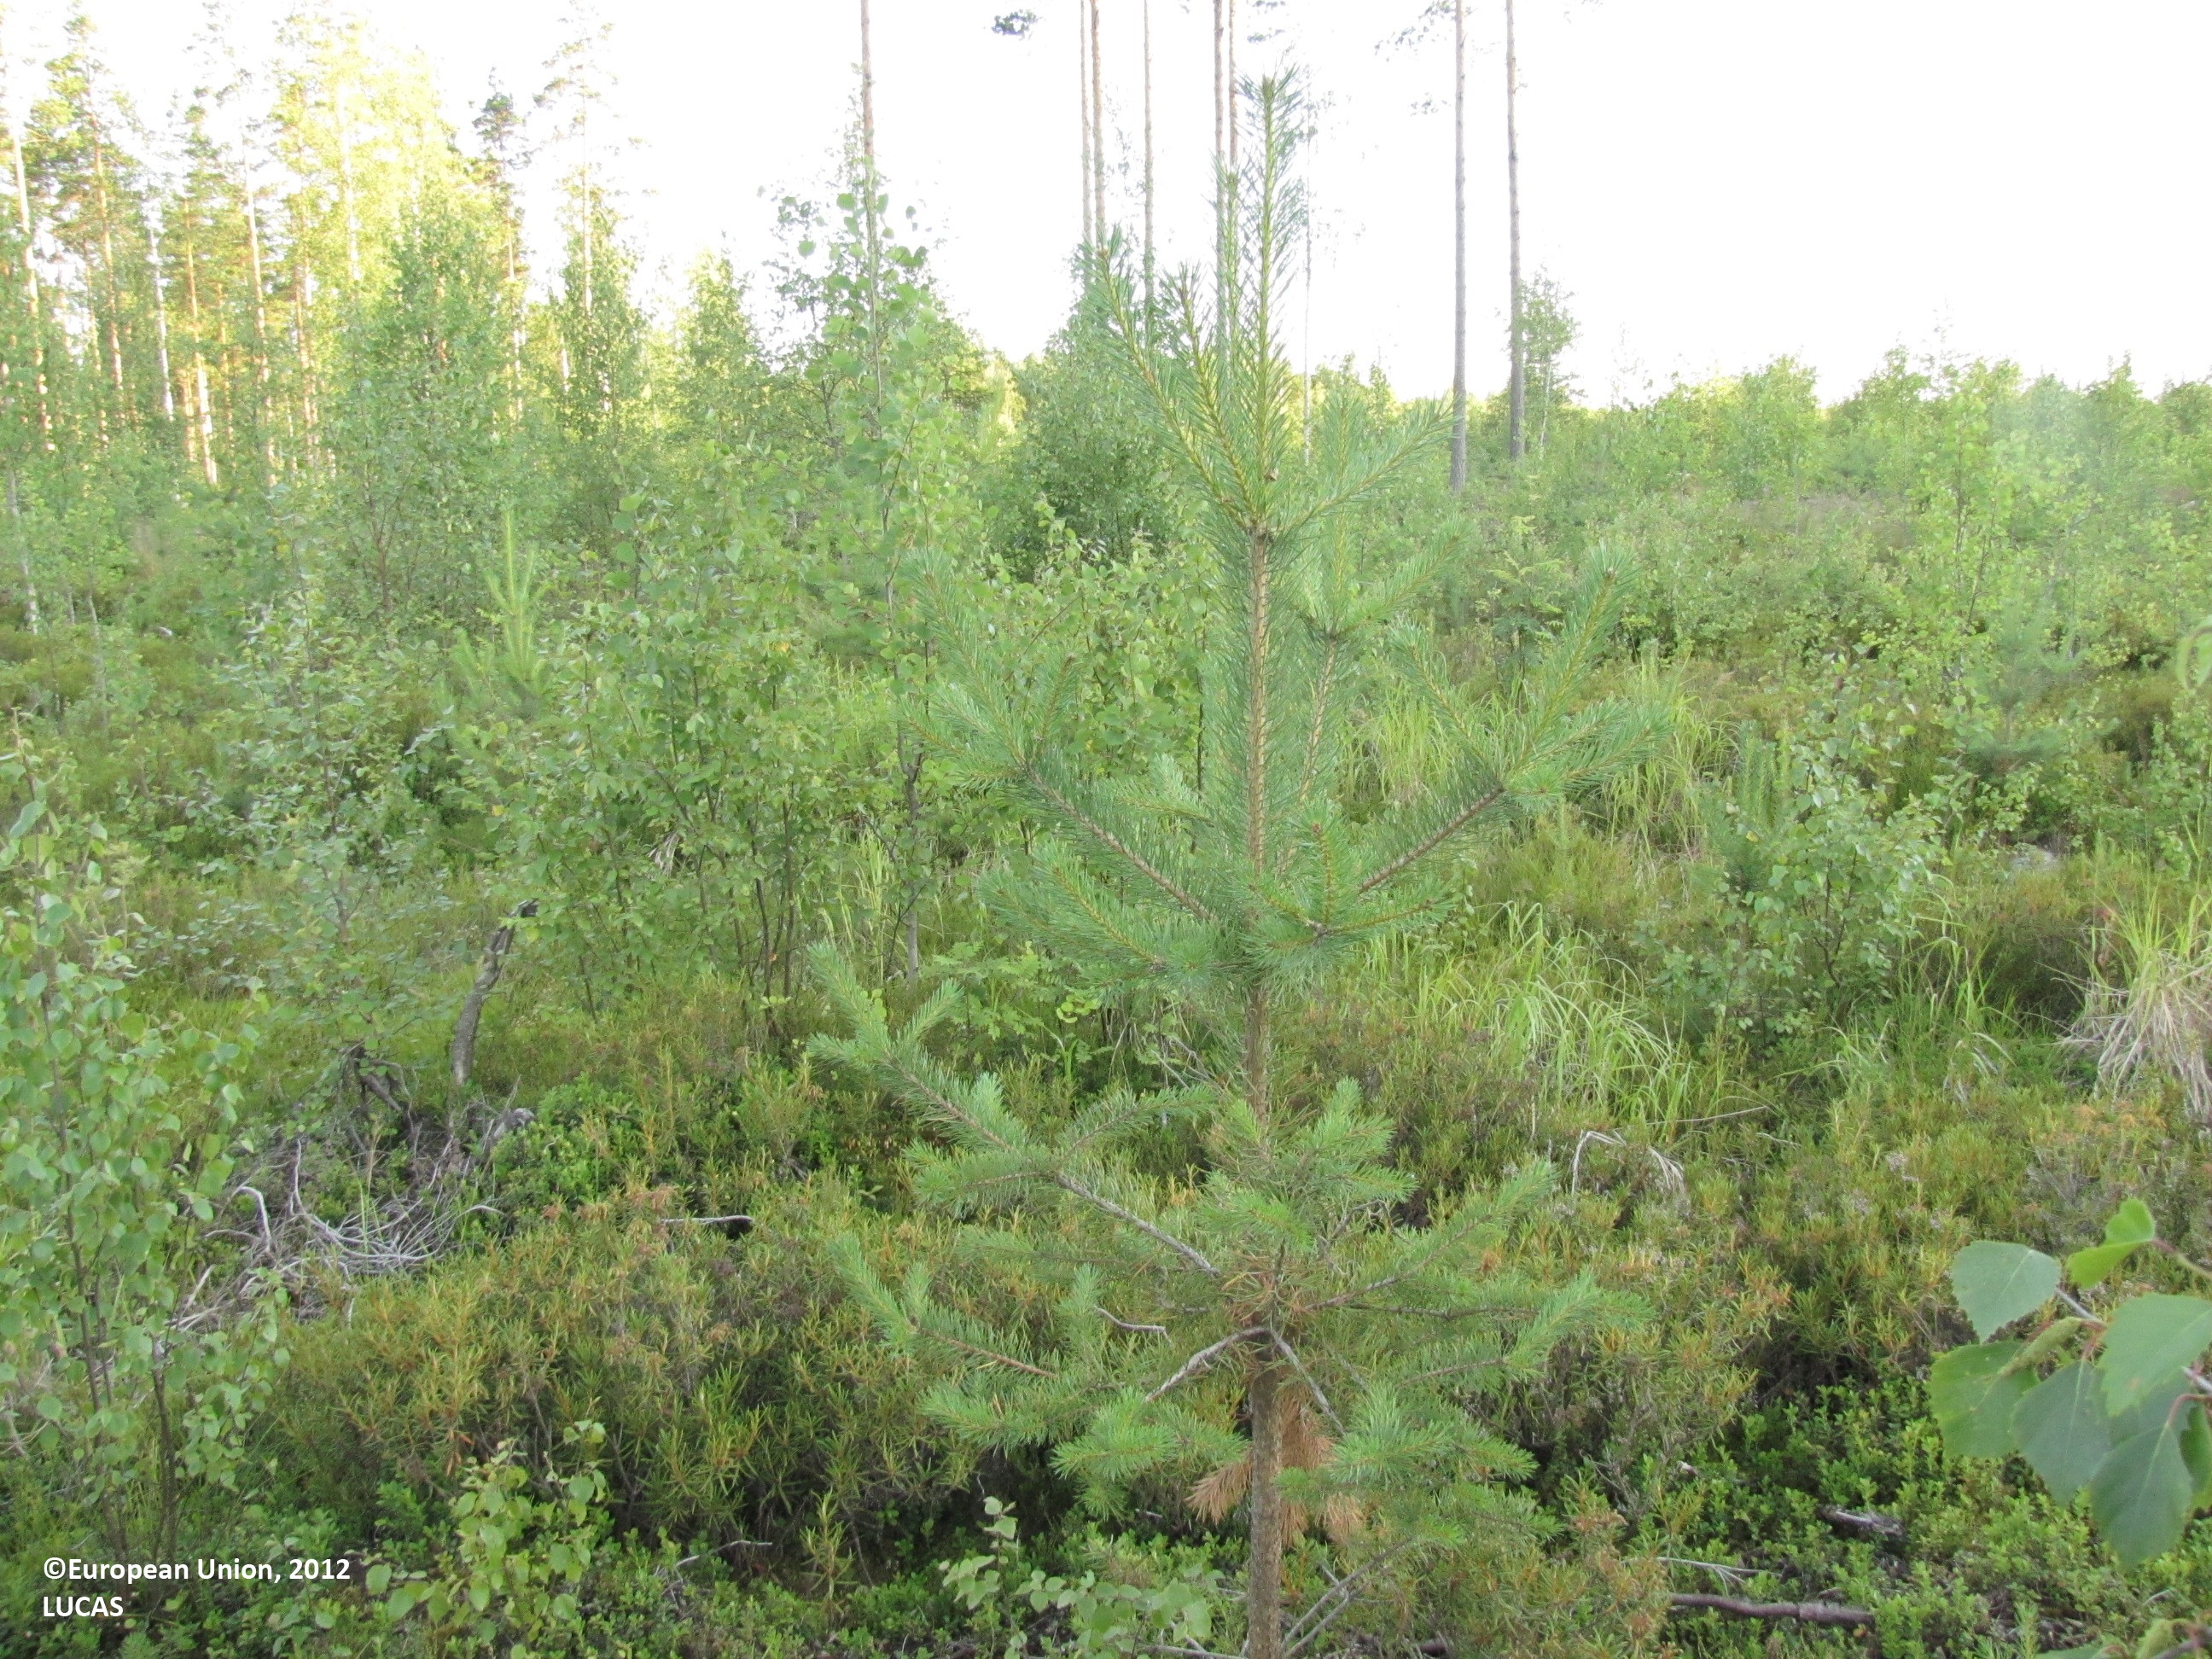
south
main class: Woodland
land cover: Broadleaved woodland
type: mire and swamp forests
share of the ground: 50 - 75 %
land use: Forestry
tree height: < 5 m
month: July
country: FI
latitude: 62.5675
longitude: 23.3174
